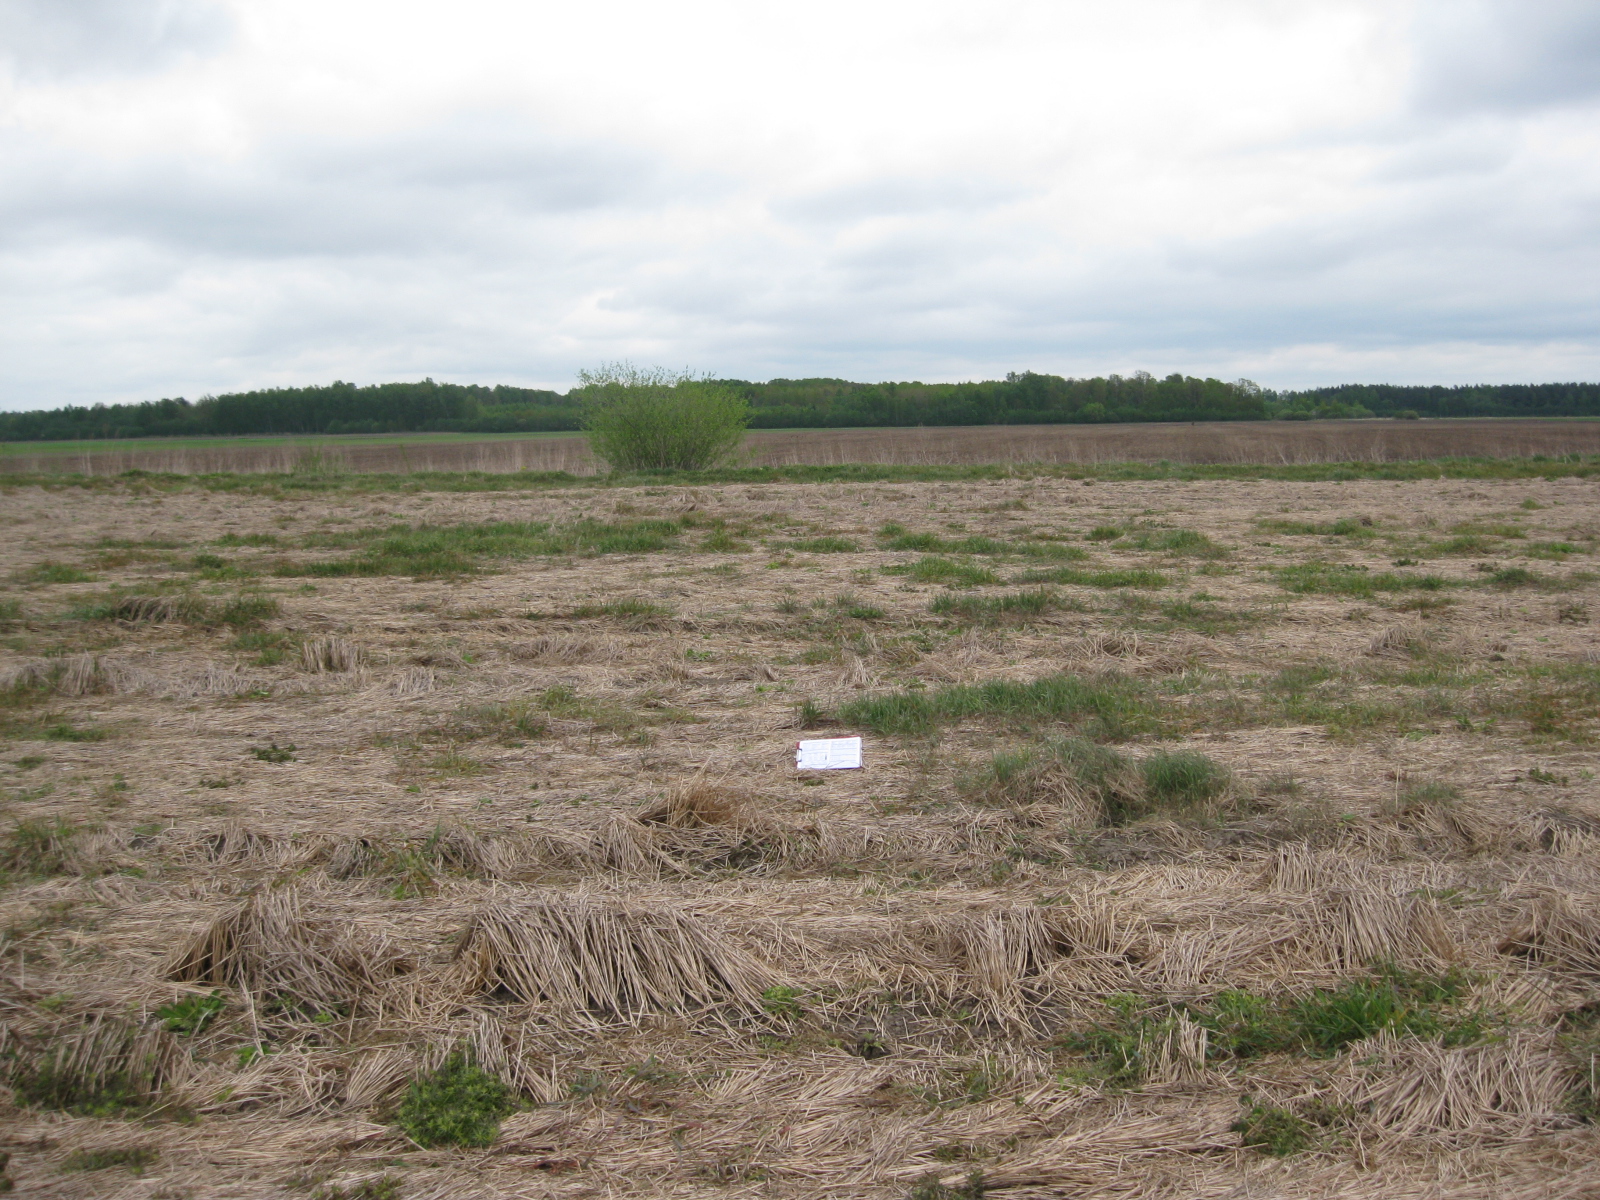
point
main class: Grassland
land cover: Spontaneously vegetated surfaces
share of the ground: 10 - 25 %
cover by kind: unconsolidated bare surface 30 %, herbaceous plants 20 %
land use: Fallow land
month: May
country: LT
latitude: 55.9413
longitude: 24.3606
